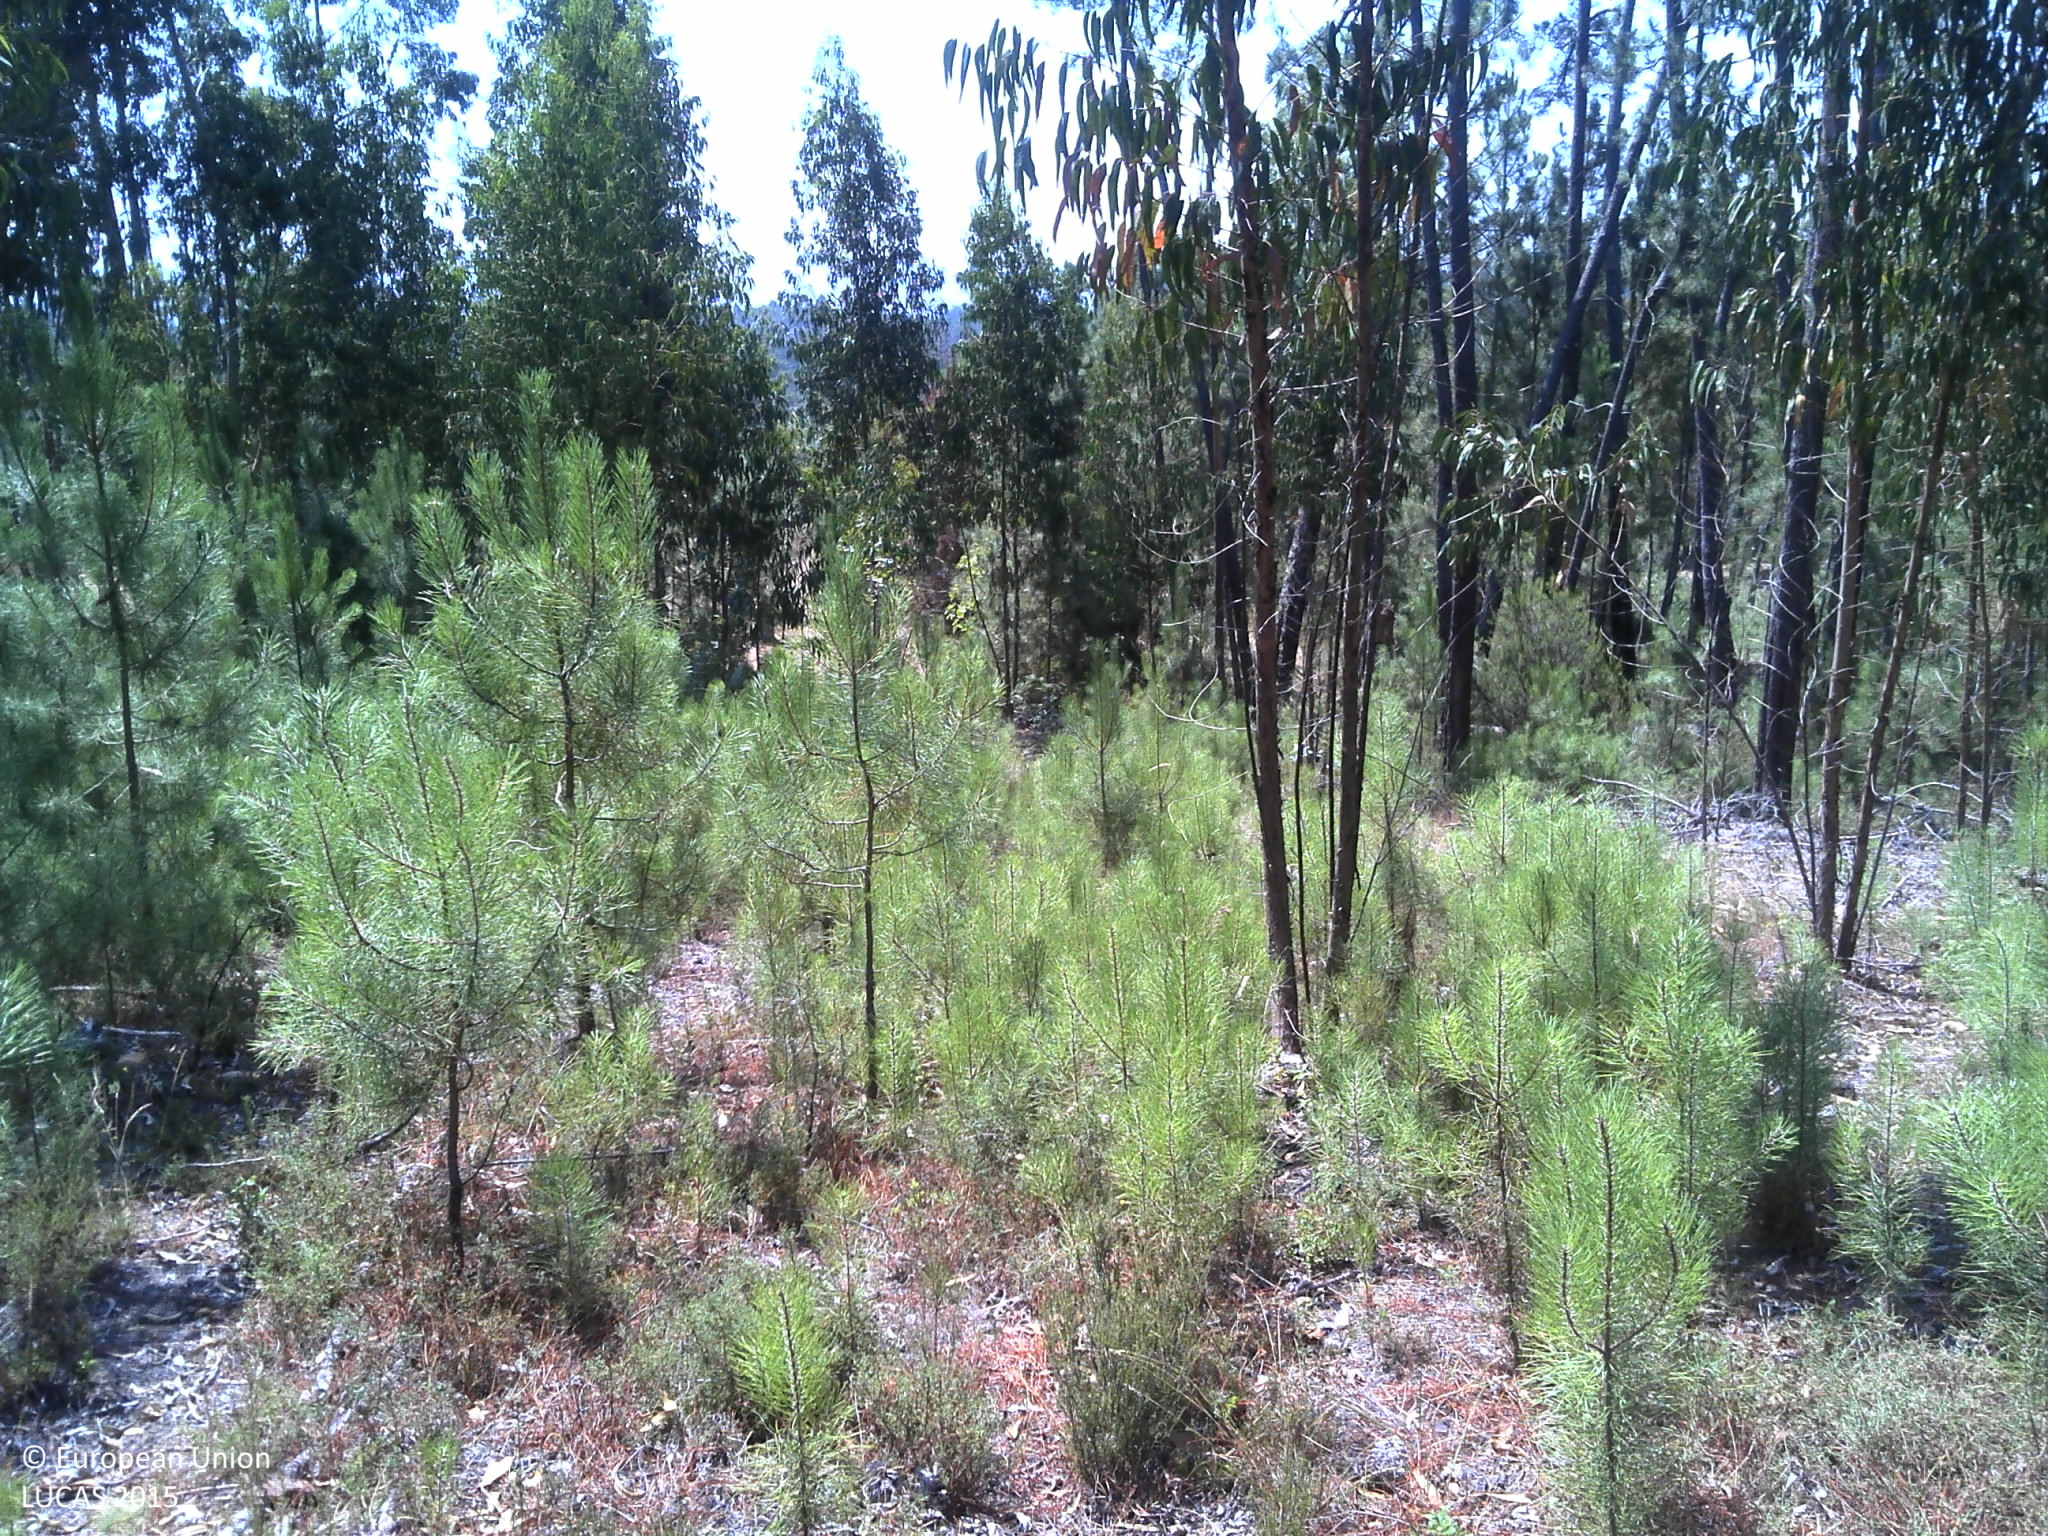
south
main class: Woodland
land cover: Pine dominated mixed woodland
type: coniferous forest of the mediterranean region
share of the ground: 10 - 25 %
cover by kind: shrubs 30 %, unconsolidated bare surface 30 %, coniferous forest trees 20 %, broadleaved forest trees 20 %
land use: Forestry
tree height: > 5 m
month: July
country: PT
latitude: 40.0715
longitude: -8.5523
